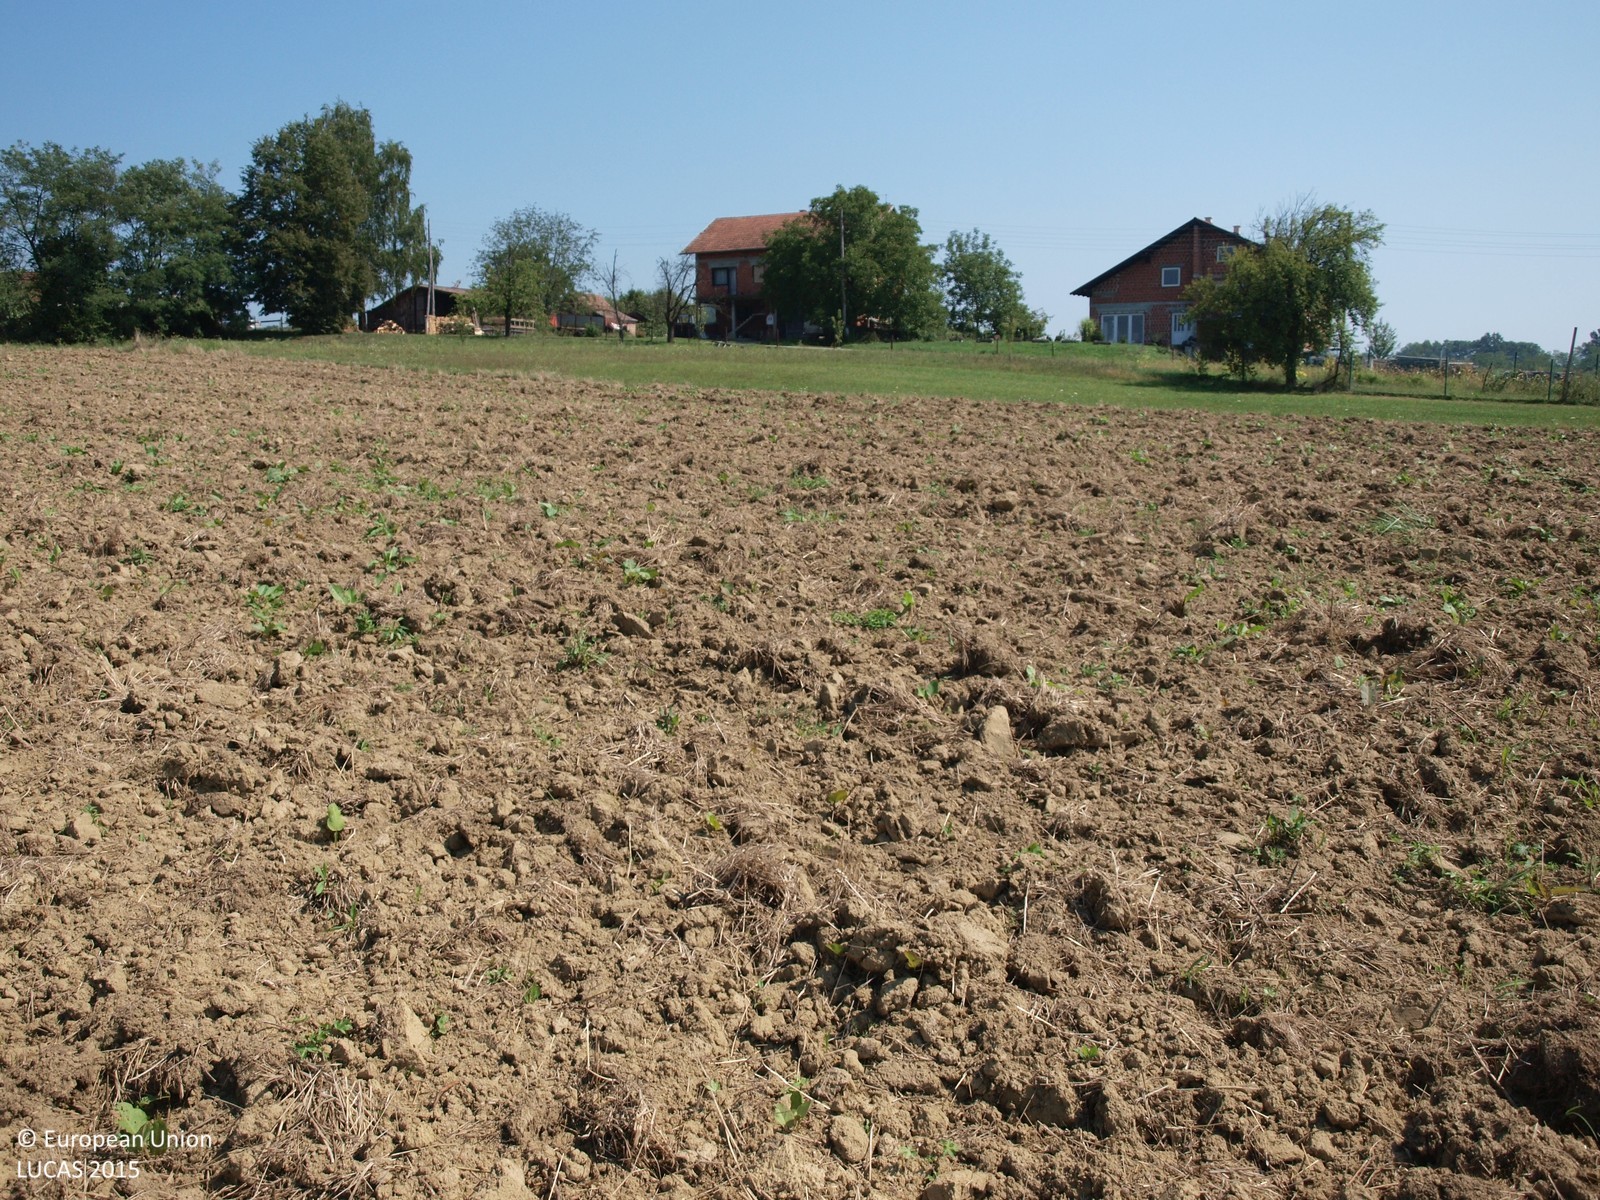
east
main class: Cropland
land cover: Common wheat
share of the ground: > 75 %
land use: Agriculture (excluding fallow land and kitchen gardens)
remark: Harvested field
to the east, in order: Common wheat; Grassland without tree/shrub cover; Artificial constructions in urban areas; Grassland without tree/shrub cover; Abandoned hedges; Grassland without tree/shrub cover; Broadleaved woodland; Grassland without tree/shrub cover
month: August
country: HR
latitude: 45.7026
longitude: 16.4849
